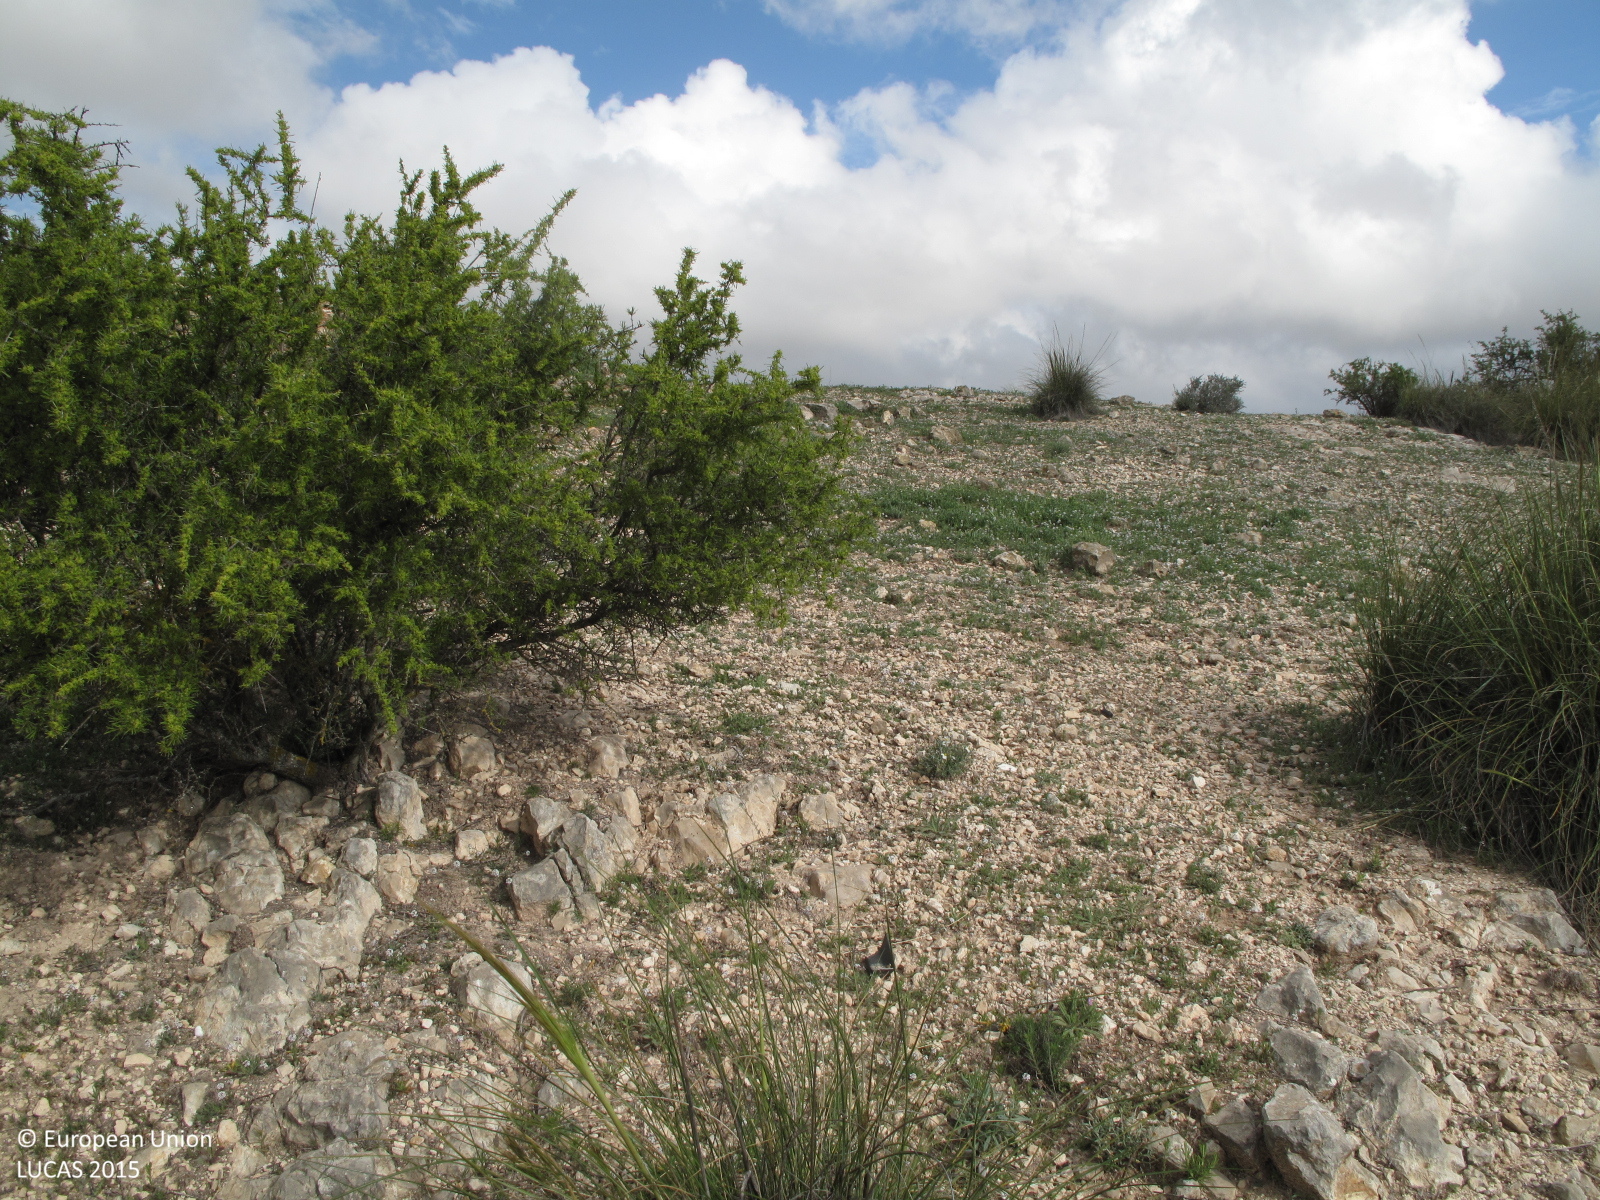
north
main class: Shrubland
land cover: Shrubland with sparse tree cover
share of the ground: 25 - 50 %
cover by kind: unconsolidated bare surface 55 %, shrubs 20 %, herbaceous plants 20 %, coniferous forest trees 5 %
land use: Semi-natural and natural areas not in use
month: April
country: ES
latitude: 38.6802
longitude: -0.9922
